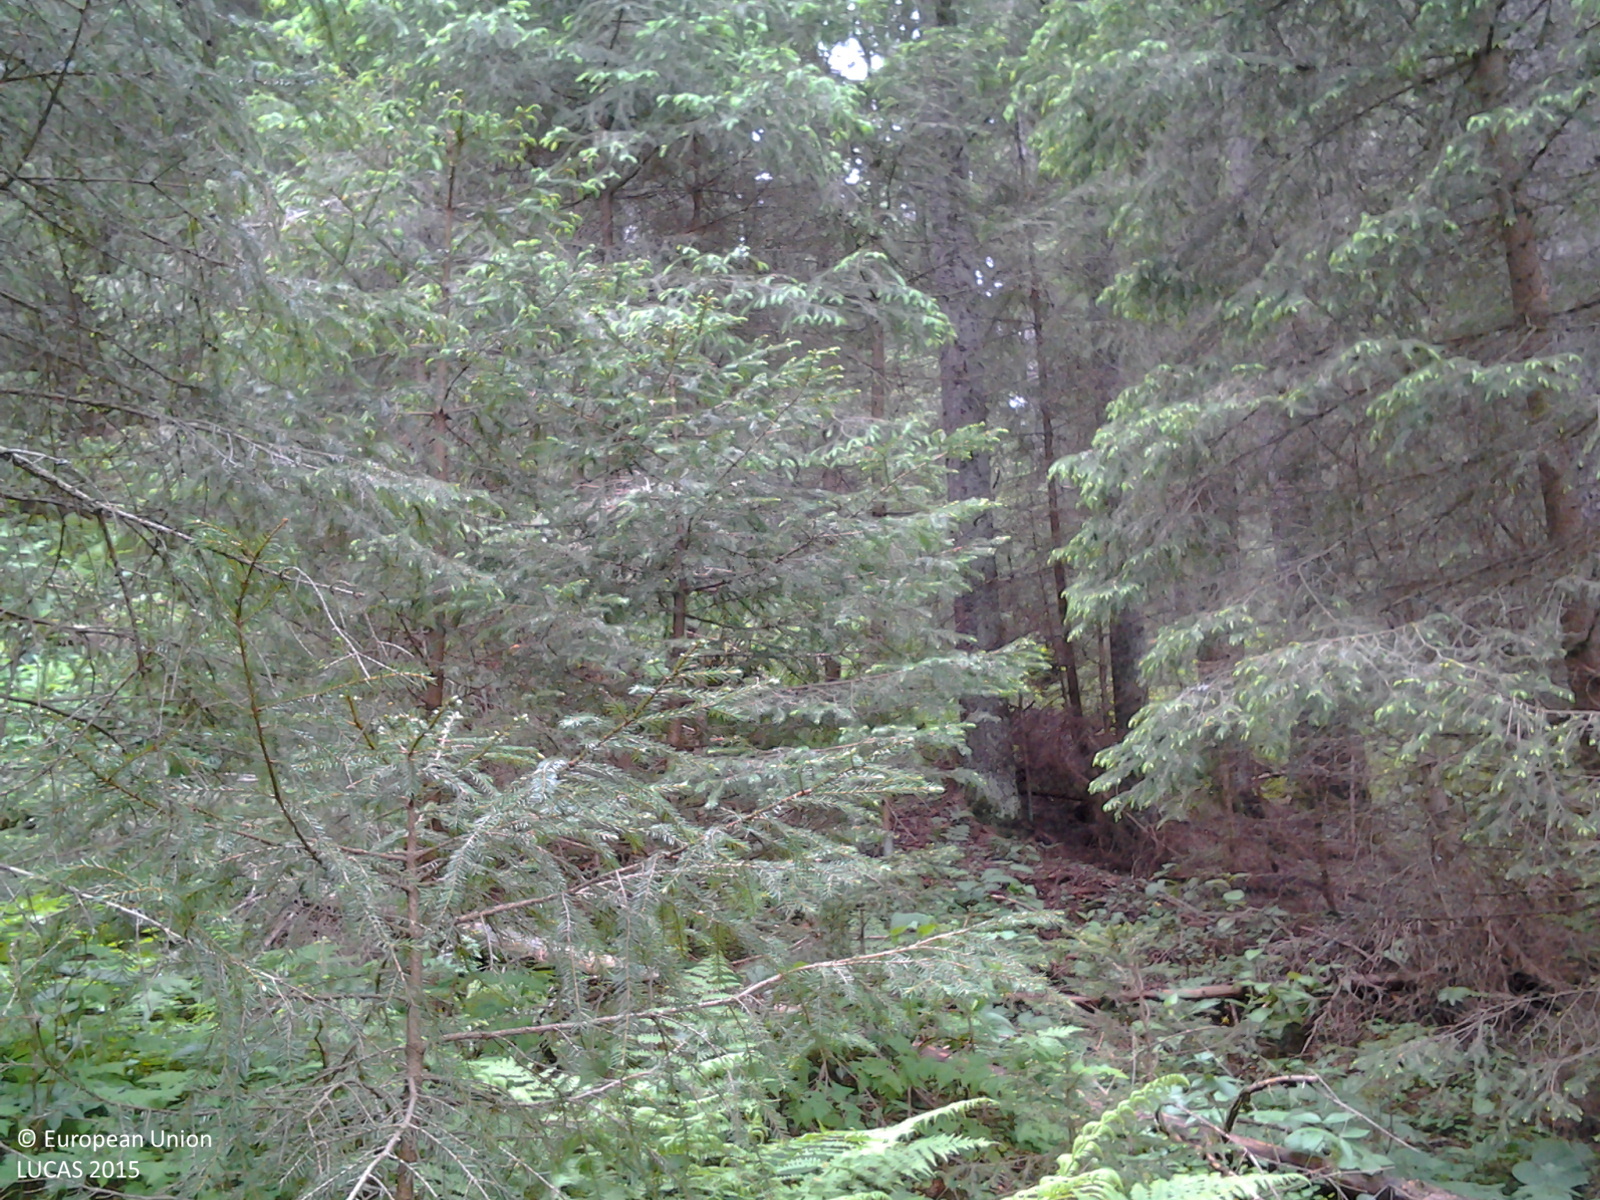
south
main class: Woodland
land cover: Spruce dominated coniferous woodland
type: alpine coniferous forest
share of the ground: > 75 %
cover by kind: coniferous forest trees 100 %
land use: Forestry
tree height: > 5 m
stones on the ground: < 10 %
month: June
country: RO
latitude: 47.7026
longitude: 25.1275
